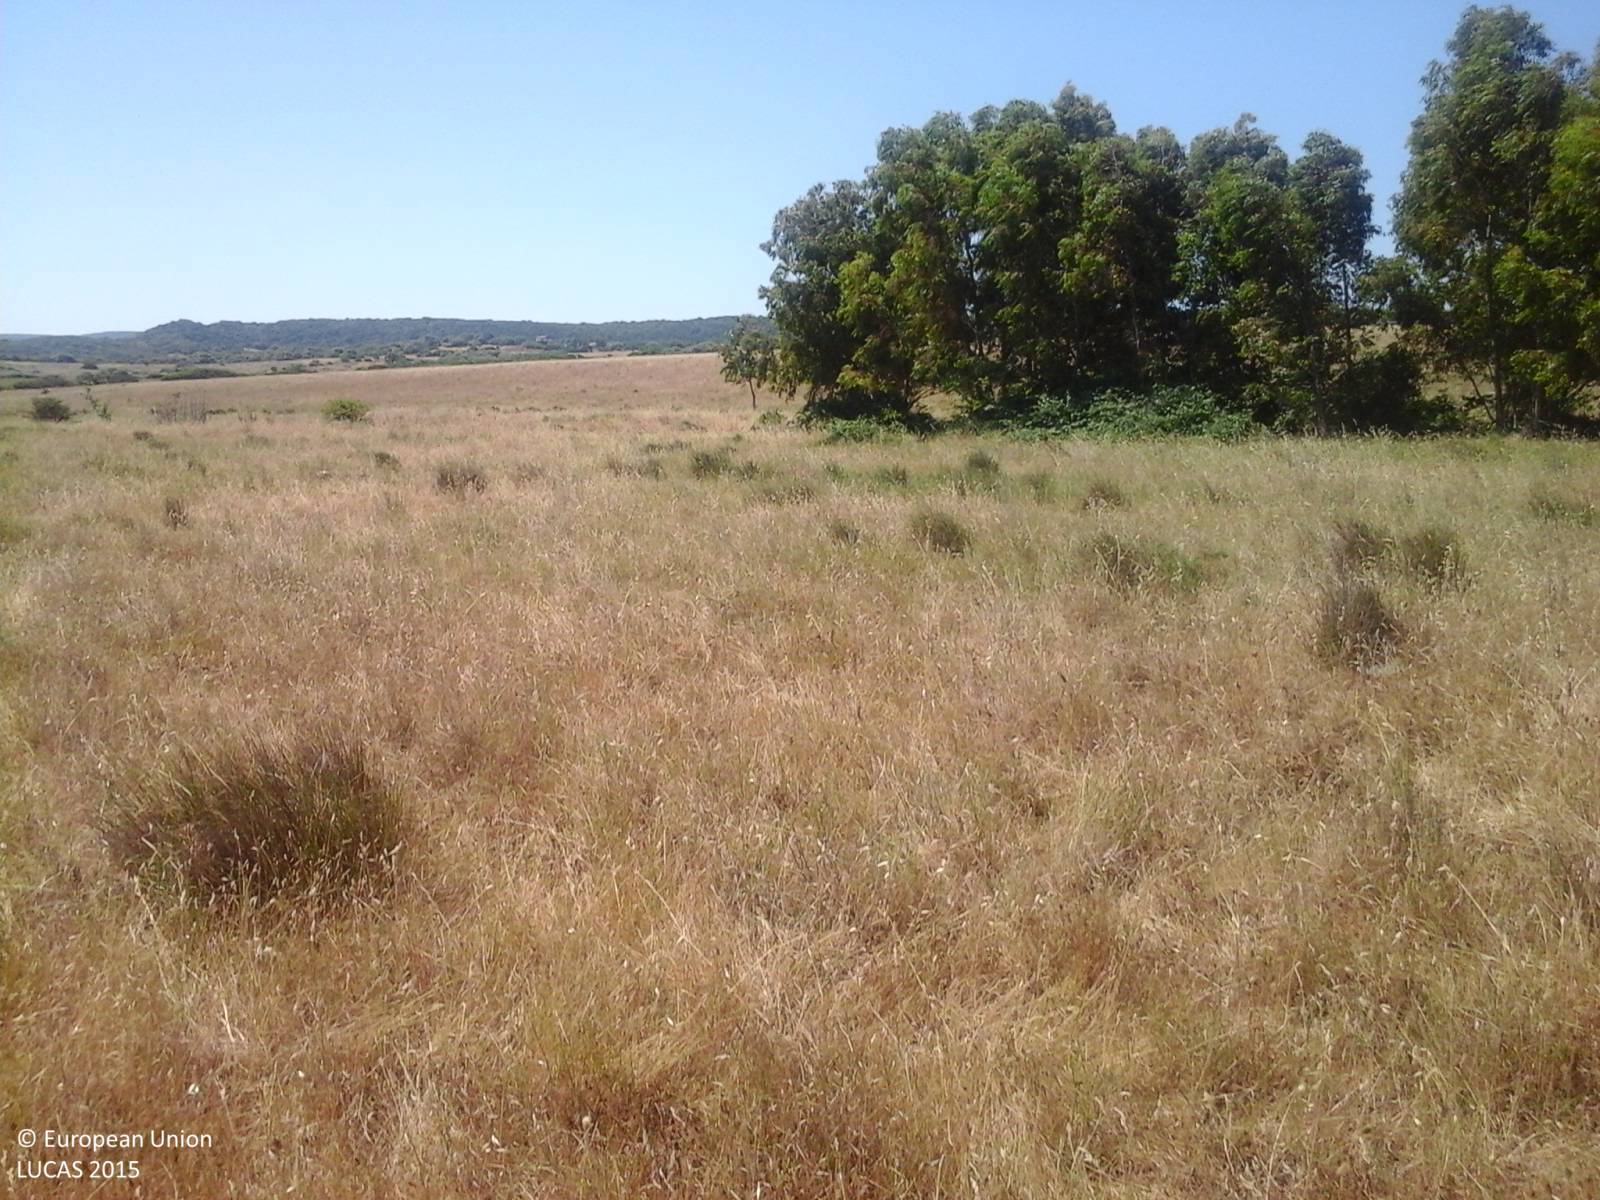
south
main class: Grassland
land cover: Grassland without tree/shrub cover
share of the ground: > 75 %
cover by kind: herbaceous plants 95 %, shrubs 5 %
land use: Agriculture (excluding fallow land and kitchen gardens)
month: June
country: IT
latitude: 40.5977
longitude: 8.3655
